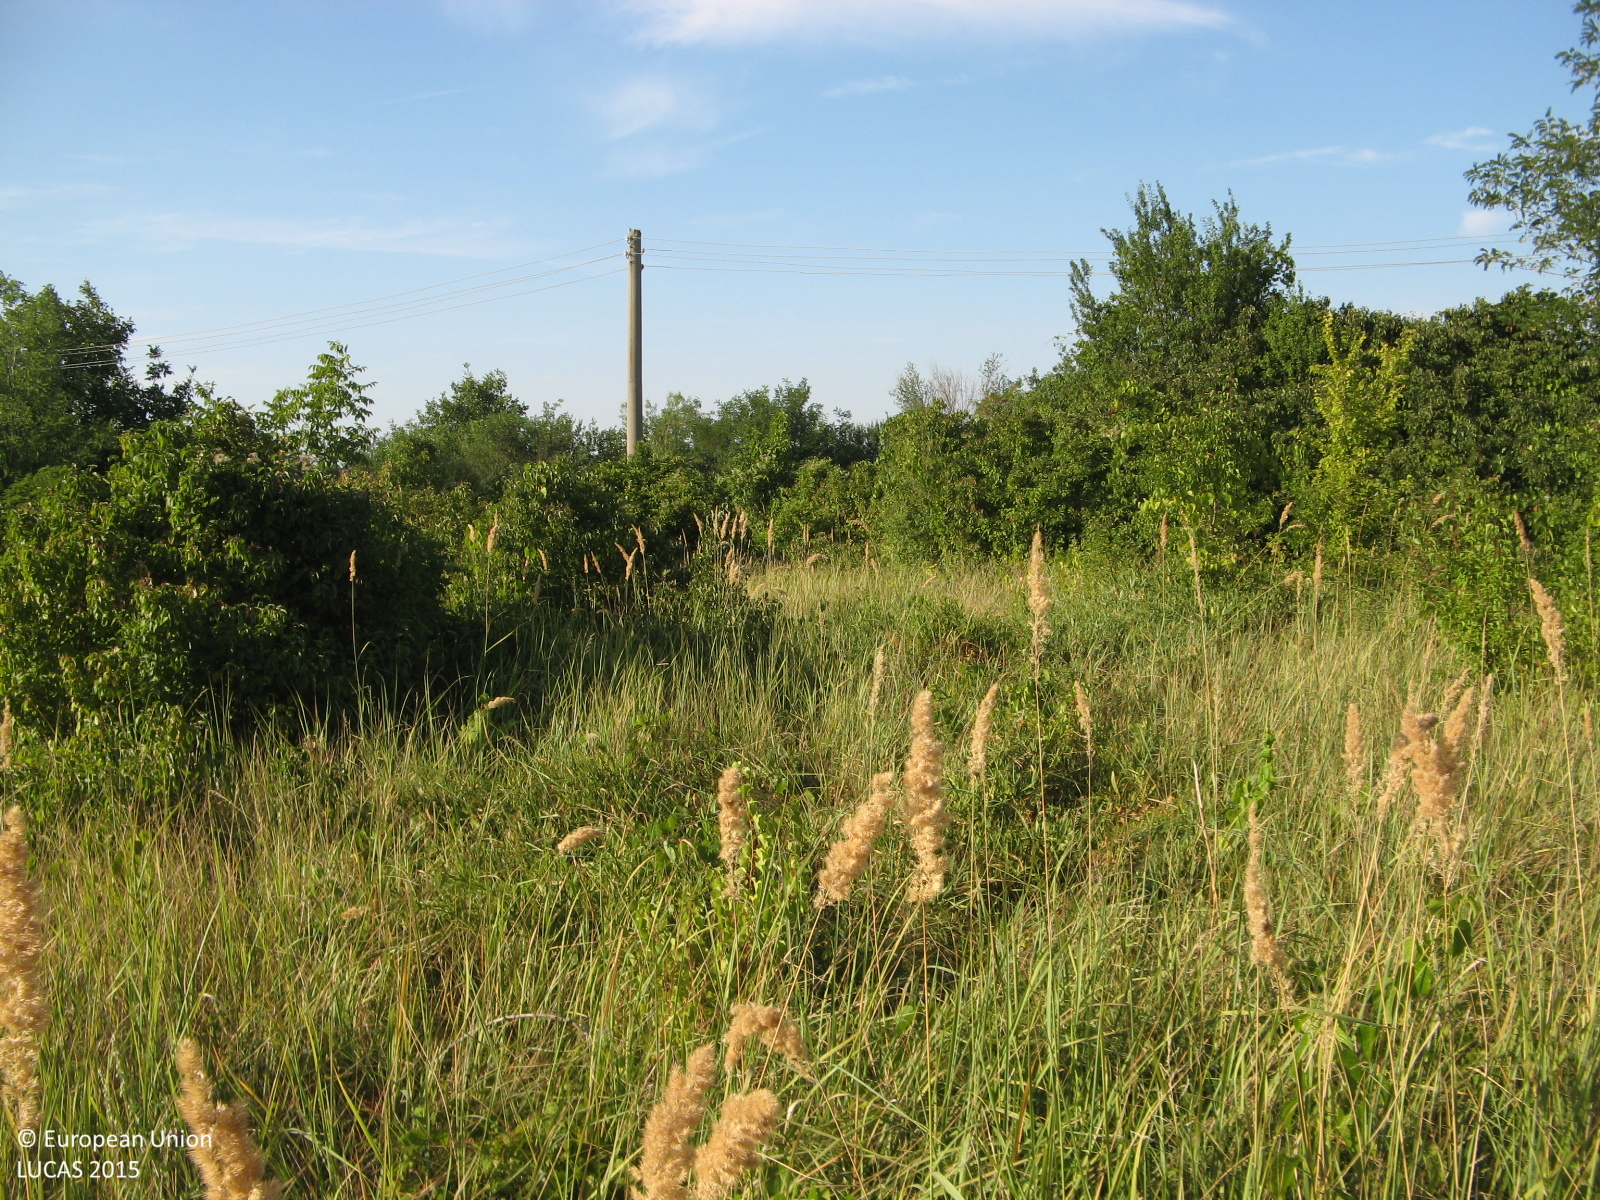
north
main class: Shrubland
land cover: Shrubland with sparse tree cover
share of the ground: 50 - 75 %
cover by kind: shrubs 50 %, herbaceous plants 45 %, broadleaved forest trees 5 %
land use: Semi-natural and natural areas not in use
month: August
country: BG
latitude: 43.6067
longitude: 25.3303
